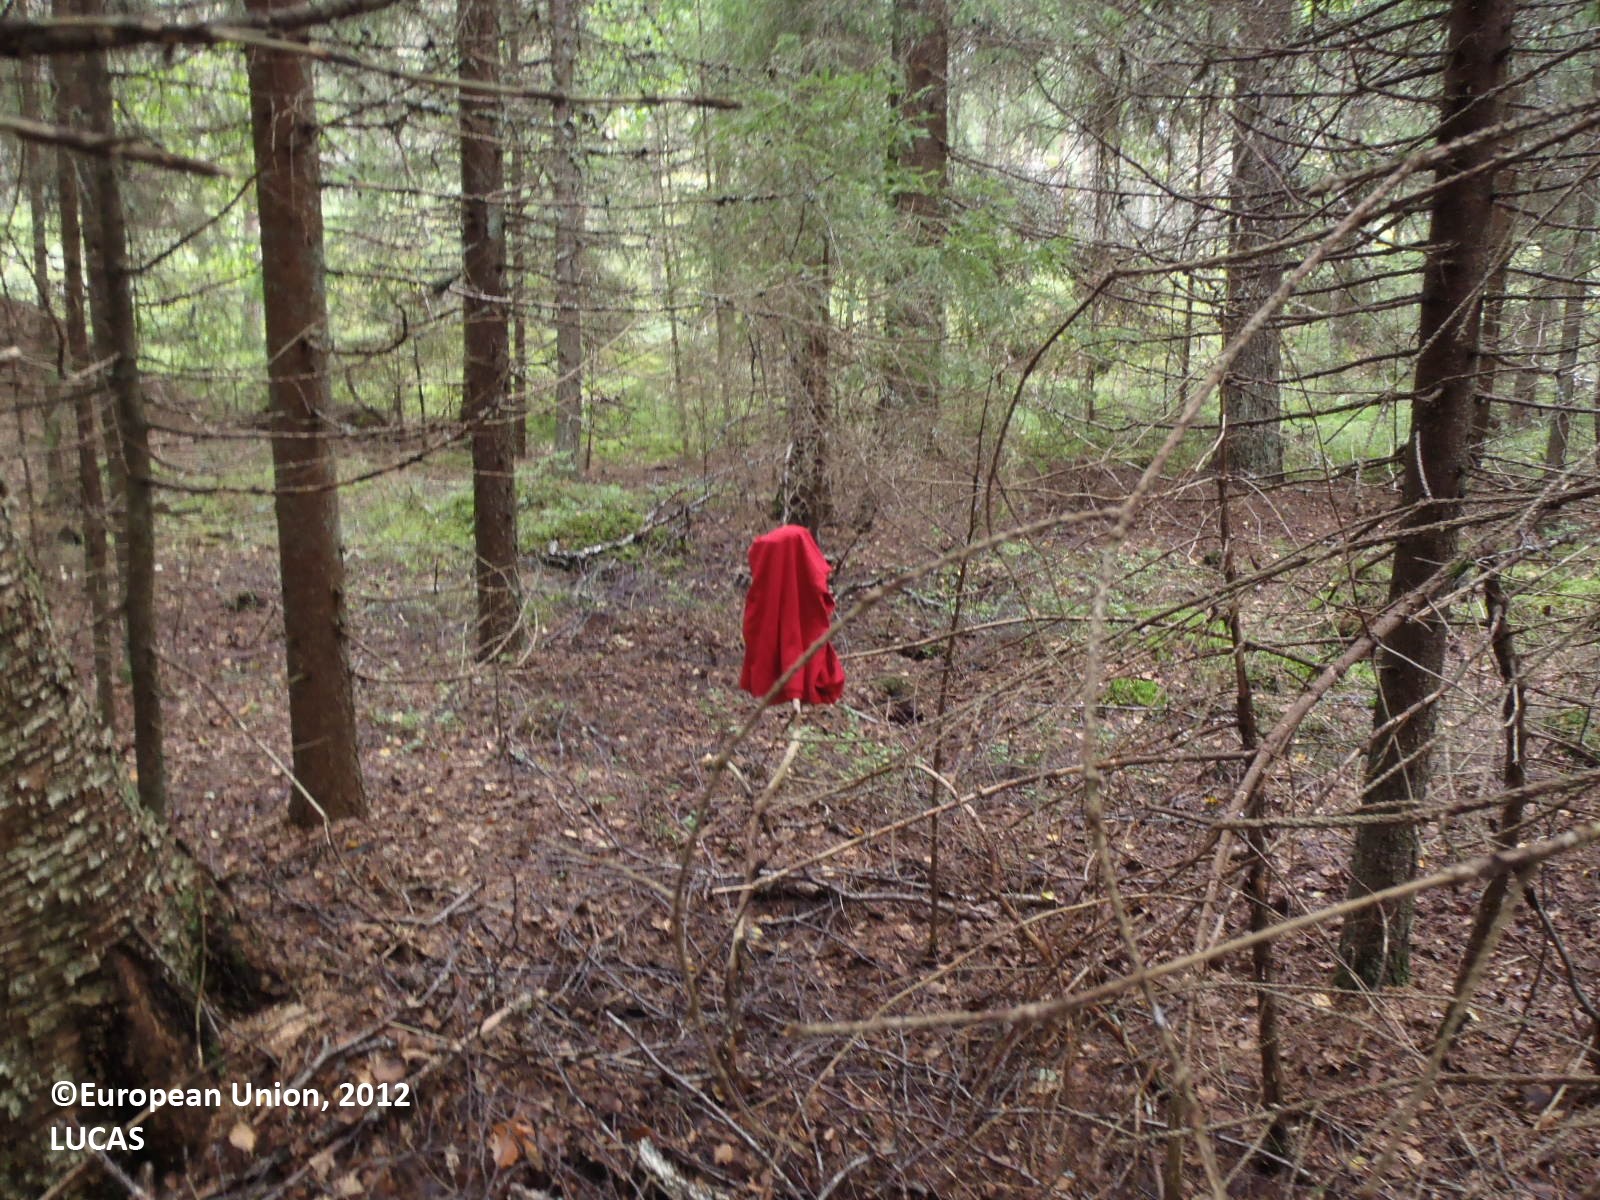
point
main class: Woodland
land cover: Spruce dominated coniferous woodland
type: boreal forest
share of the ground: > 75 %
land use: Forestry
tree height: > 5 m
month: August
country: FI
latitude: 60.7545
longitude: 21.8584
